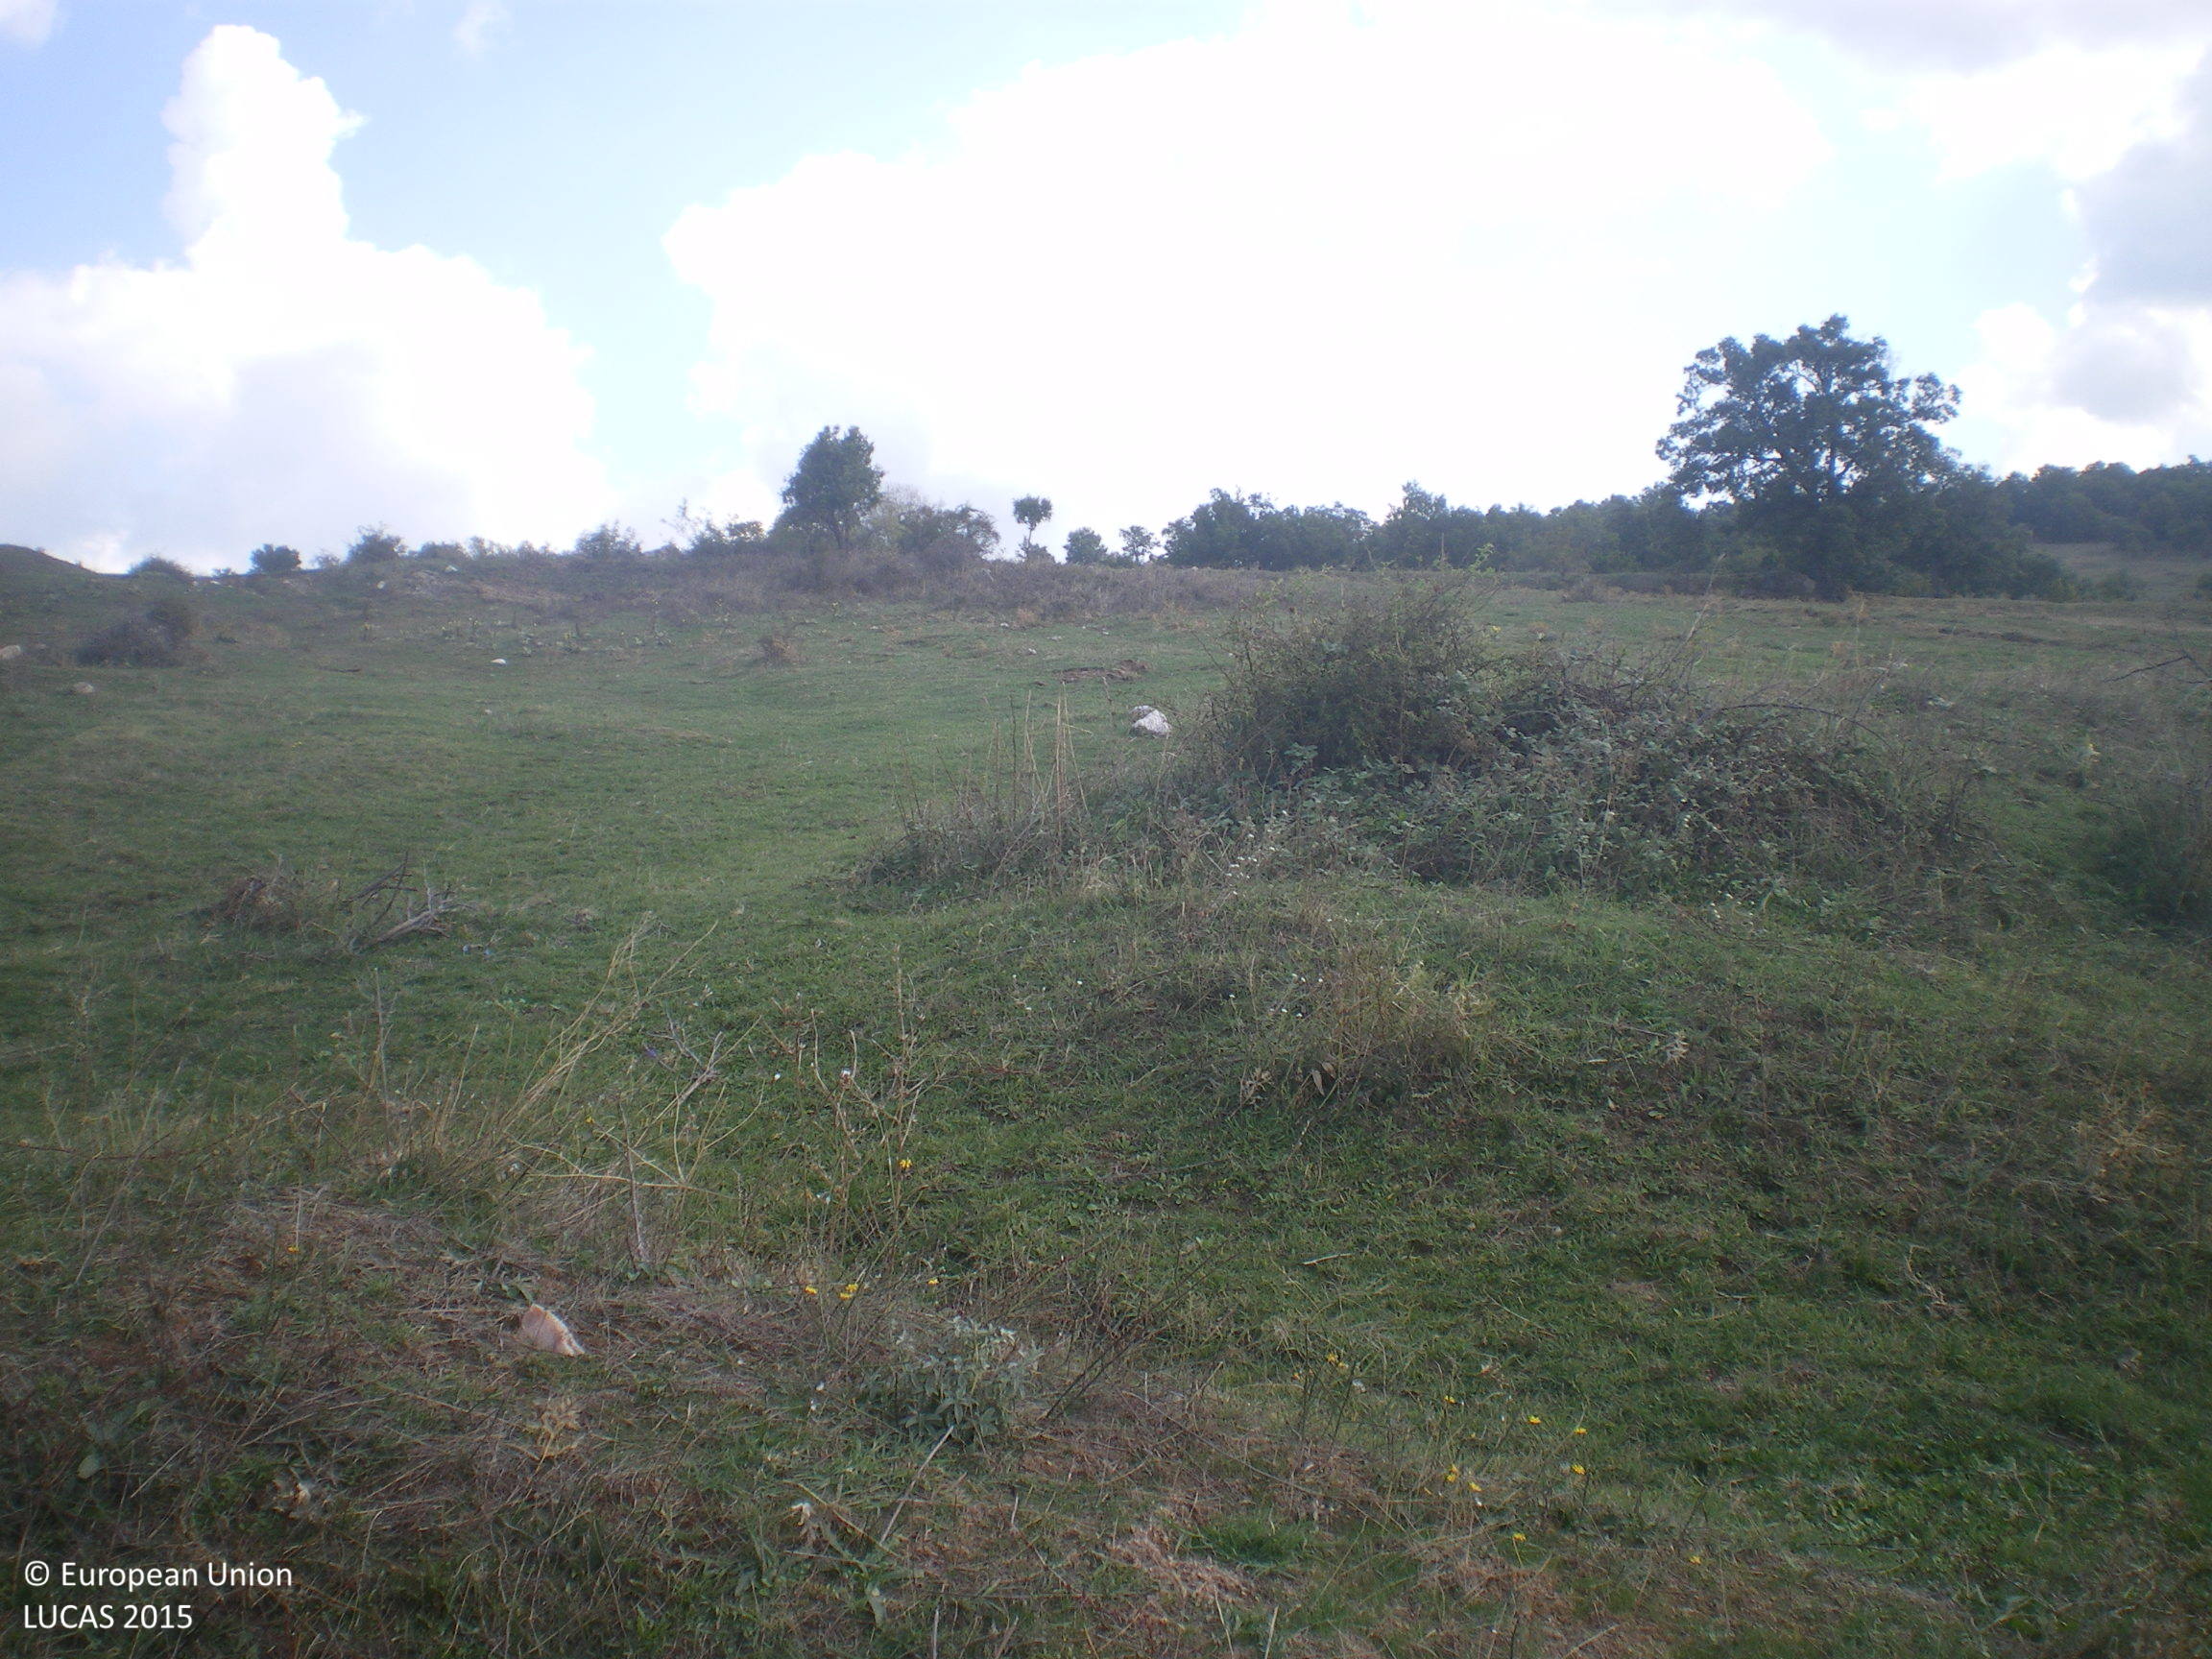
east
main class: Grassland
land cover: Grassland without tree/shrub cover
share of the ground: > 75 %
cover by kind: herbaceous plants 100 %
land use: Agriculture (excluding fallow land and kitchen gardens)
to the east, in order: Grassland without tree/shrub cover; Shrubland without tree cover; Grass margins; Tracks; Grassland with sparse tree/shrub cover; Grassland without tree/shrub cover; Broadleaved woodland; Ditches and canals; Fences; Grassland without tree/shrub cover
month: October
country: BG
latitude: 41.9690
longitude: 26.2863
